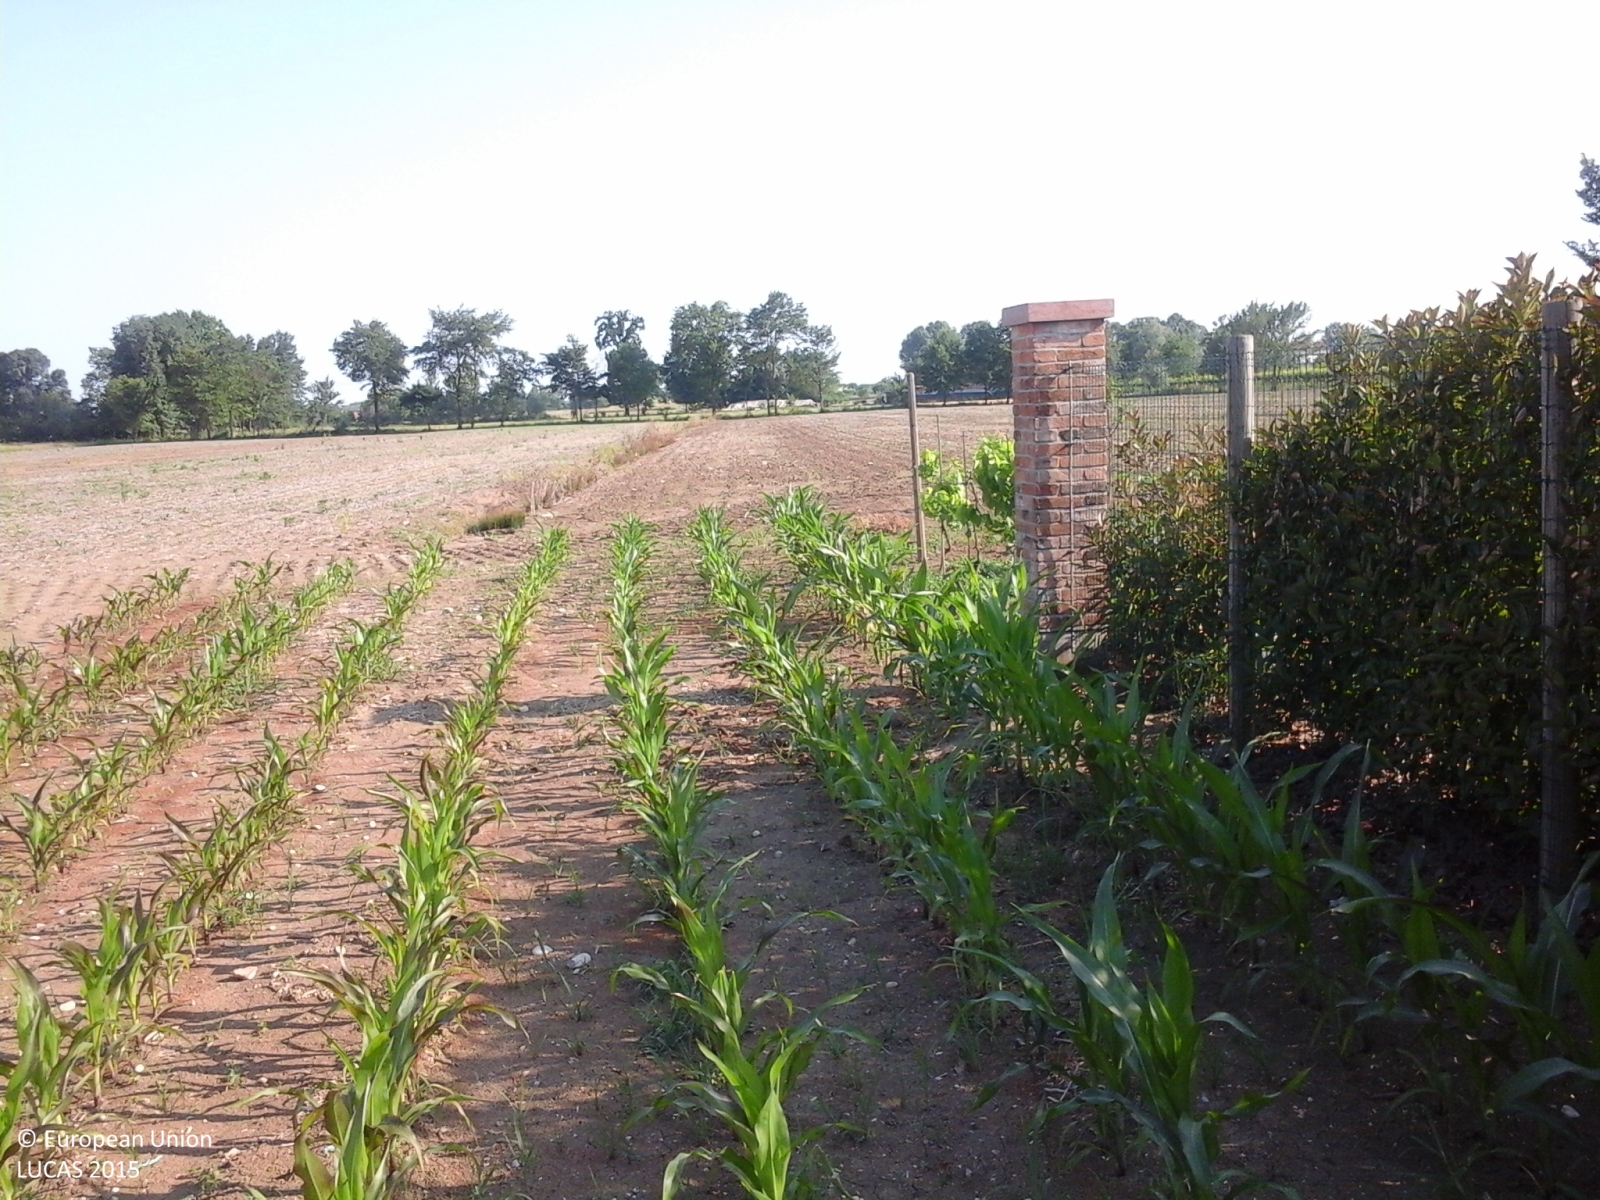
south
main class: Grassland
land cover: Grassland without tree/shrub cover
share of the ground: > 75 %
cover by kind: herbaceous plants 100 %
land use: Residential
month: June
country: IT
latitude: 45.6407
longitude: 12.3444
